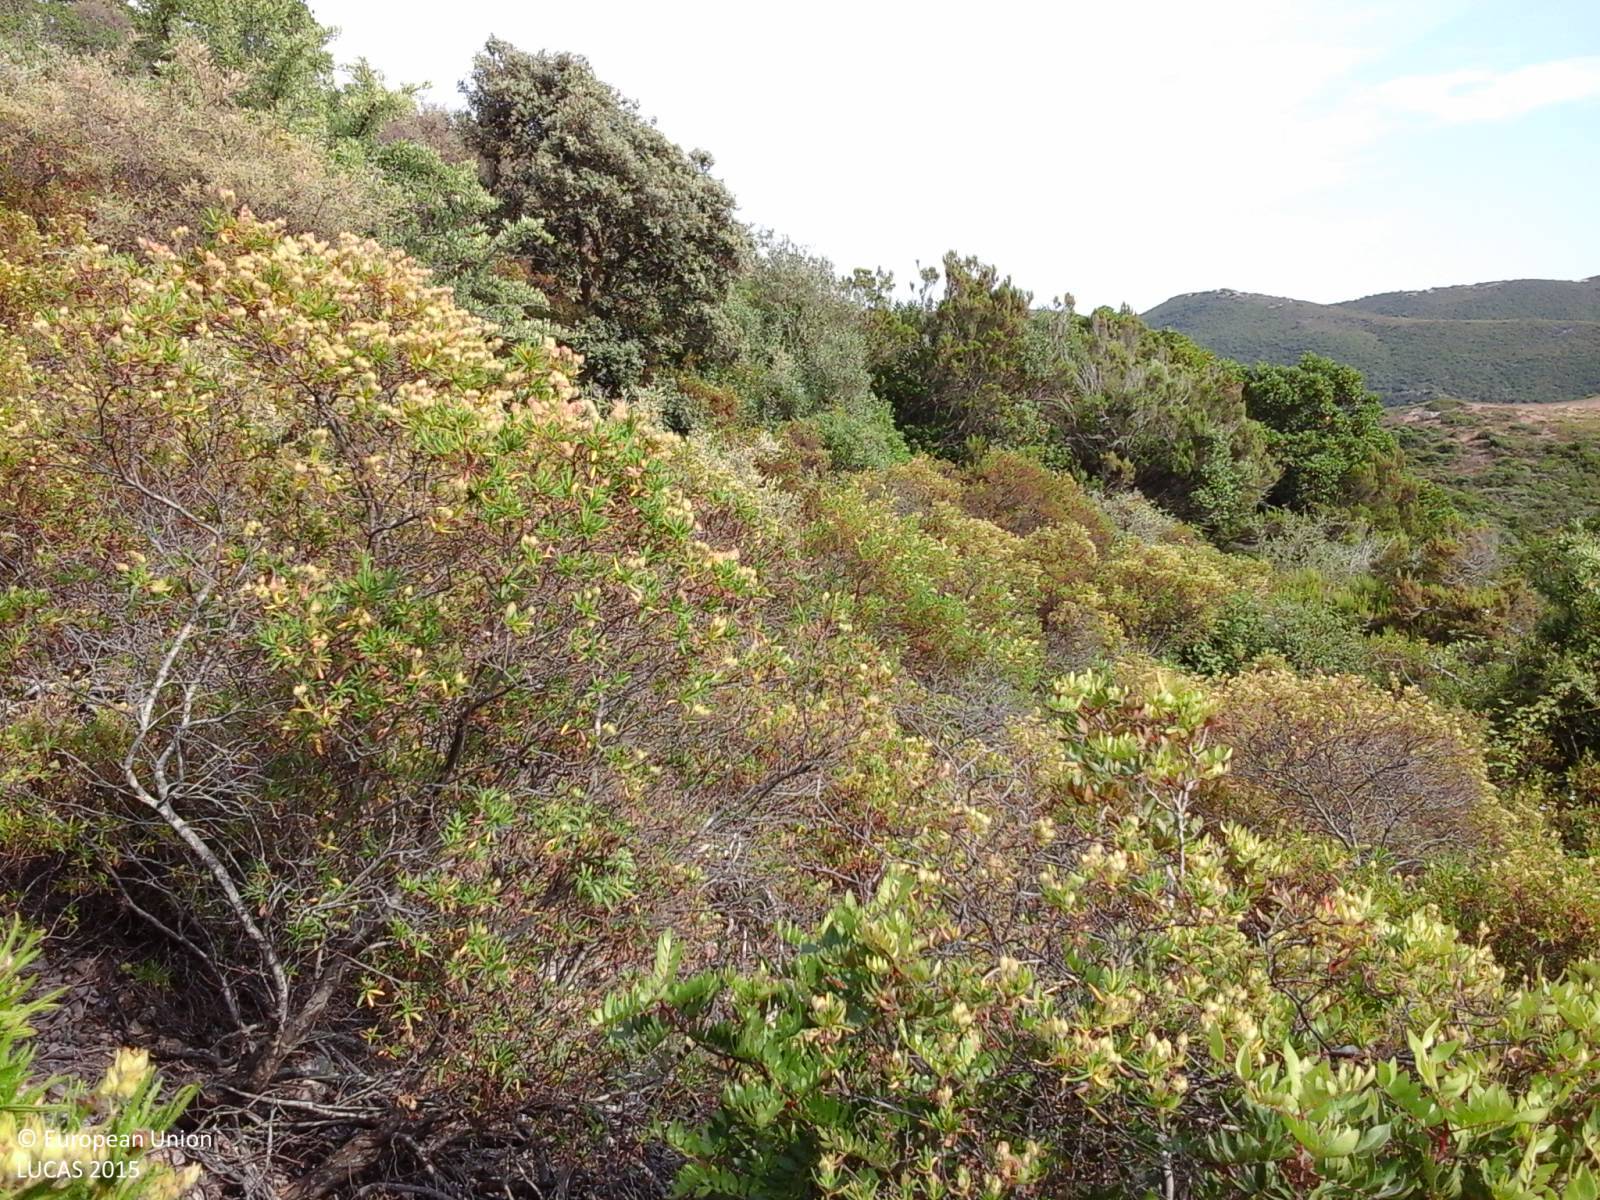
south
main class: Shrubland
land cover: Shrubland without tree cover
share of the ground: > 75 %
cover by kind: shrubs 70 %, herbaceous plants 30 %
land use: Agriculture (excluding fallow land and kitchen gardens)
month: June
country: IT
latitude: 39.6040
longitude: 8.5063
